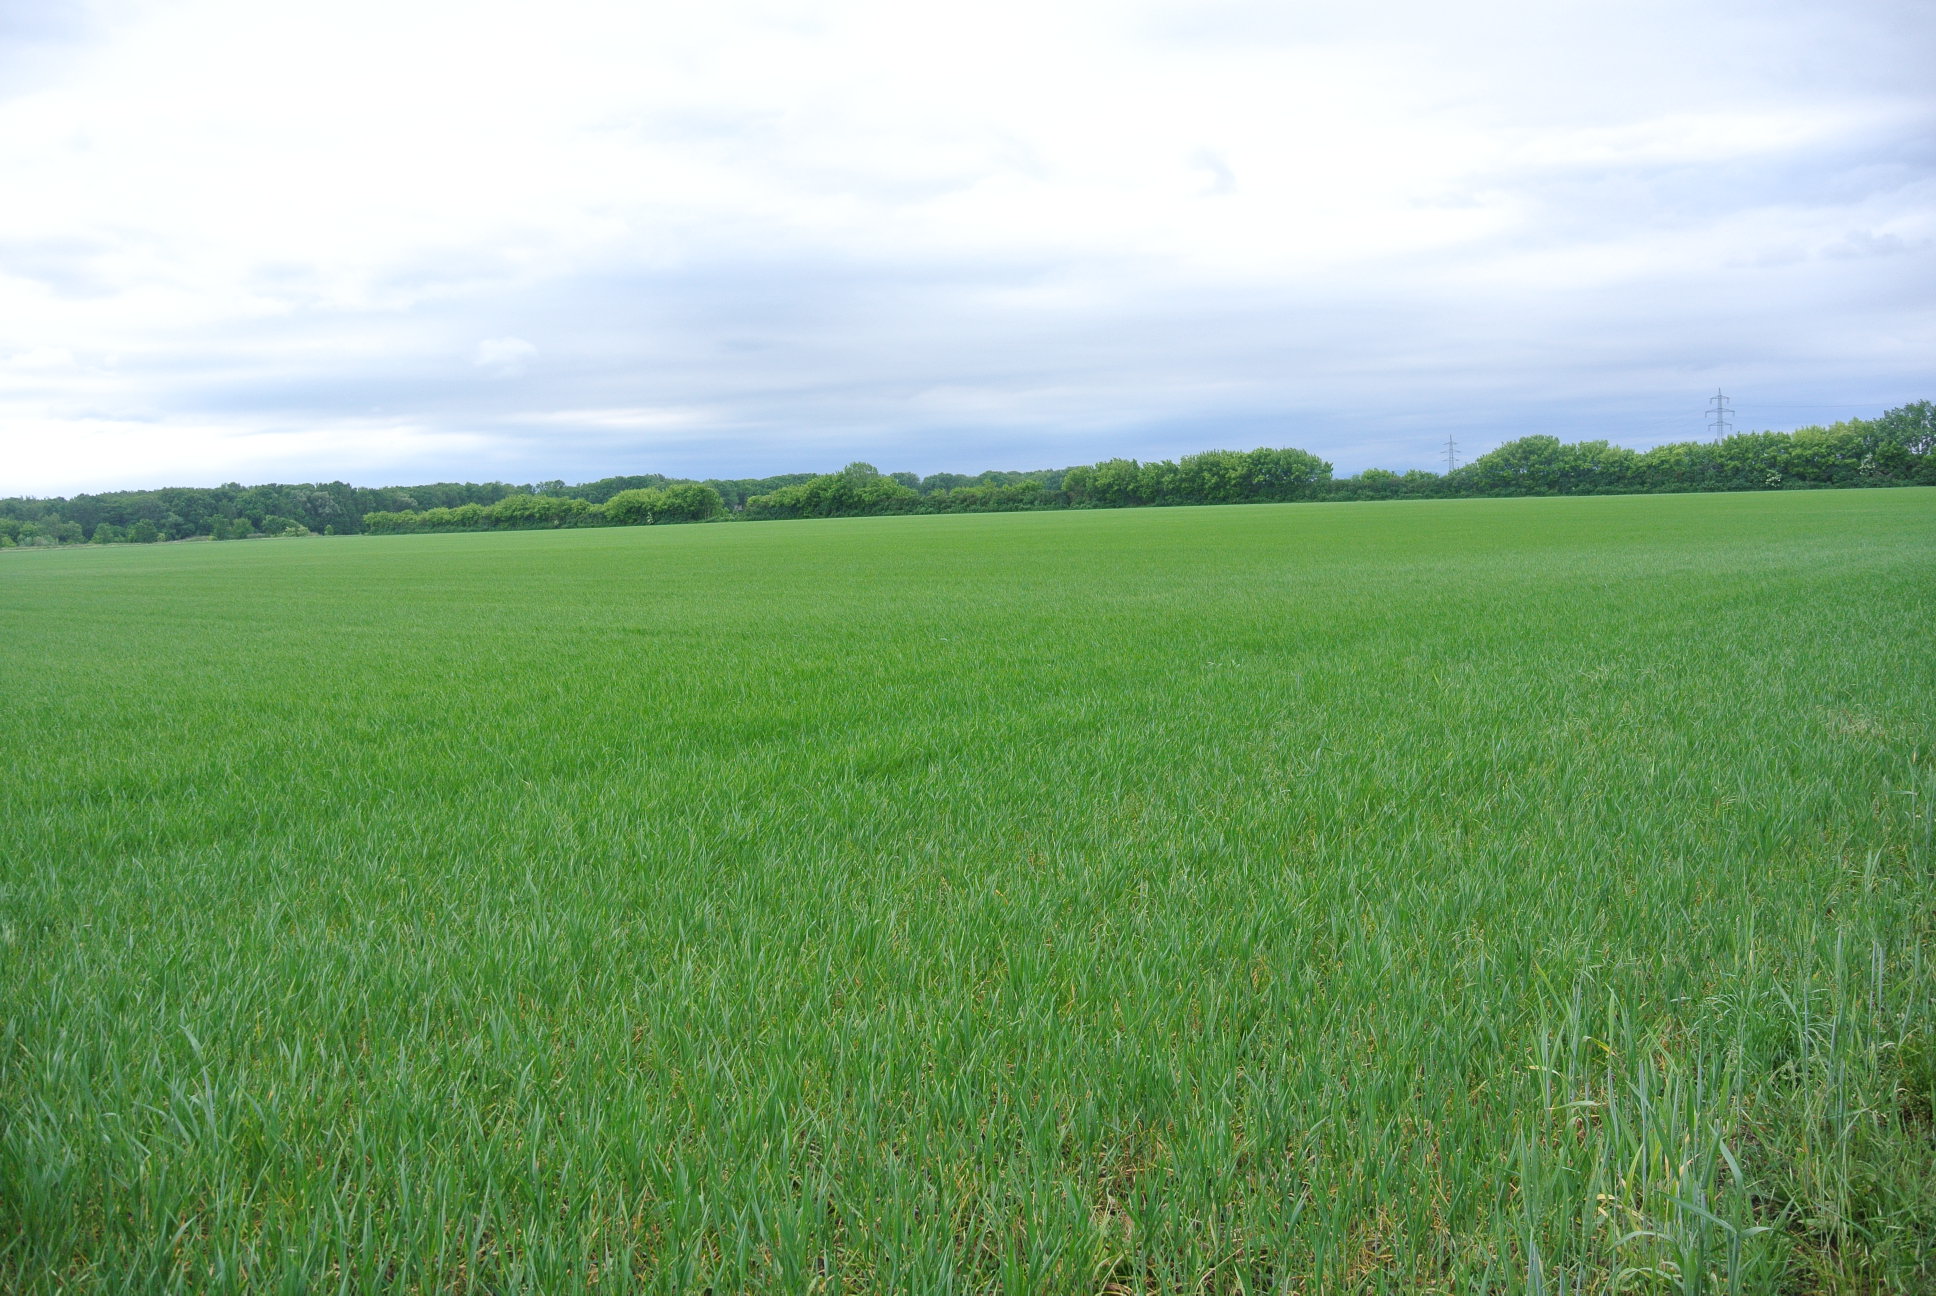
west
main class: Woodland
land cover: Broadleaved woodland
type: beech forest
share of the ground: > 75 %
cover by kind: broadleaved forest trees 100 %
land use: Semi-natural and natural areas not in use
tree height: > 5 m
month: May
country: AT
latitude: 48.0247
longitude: 16.6162
